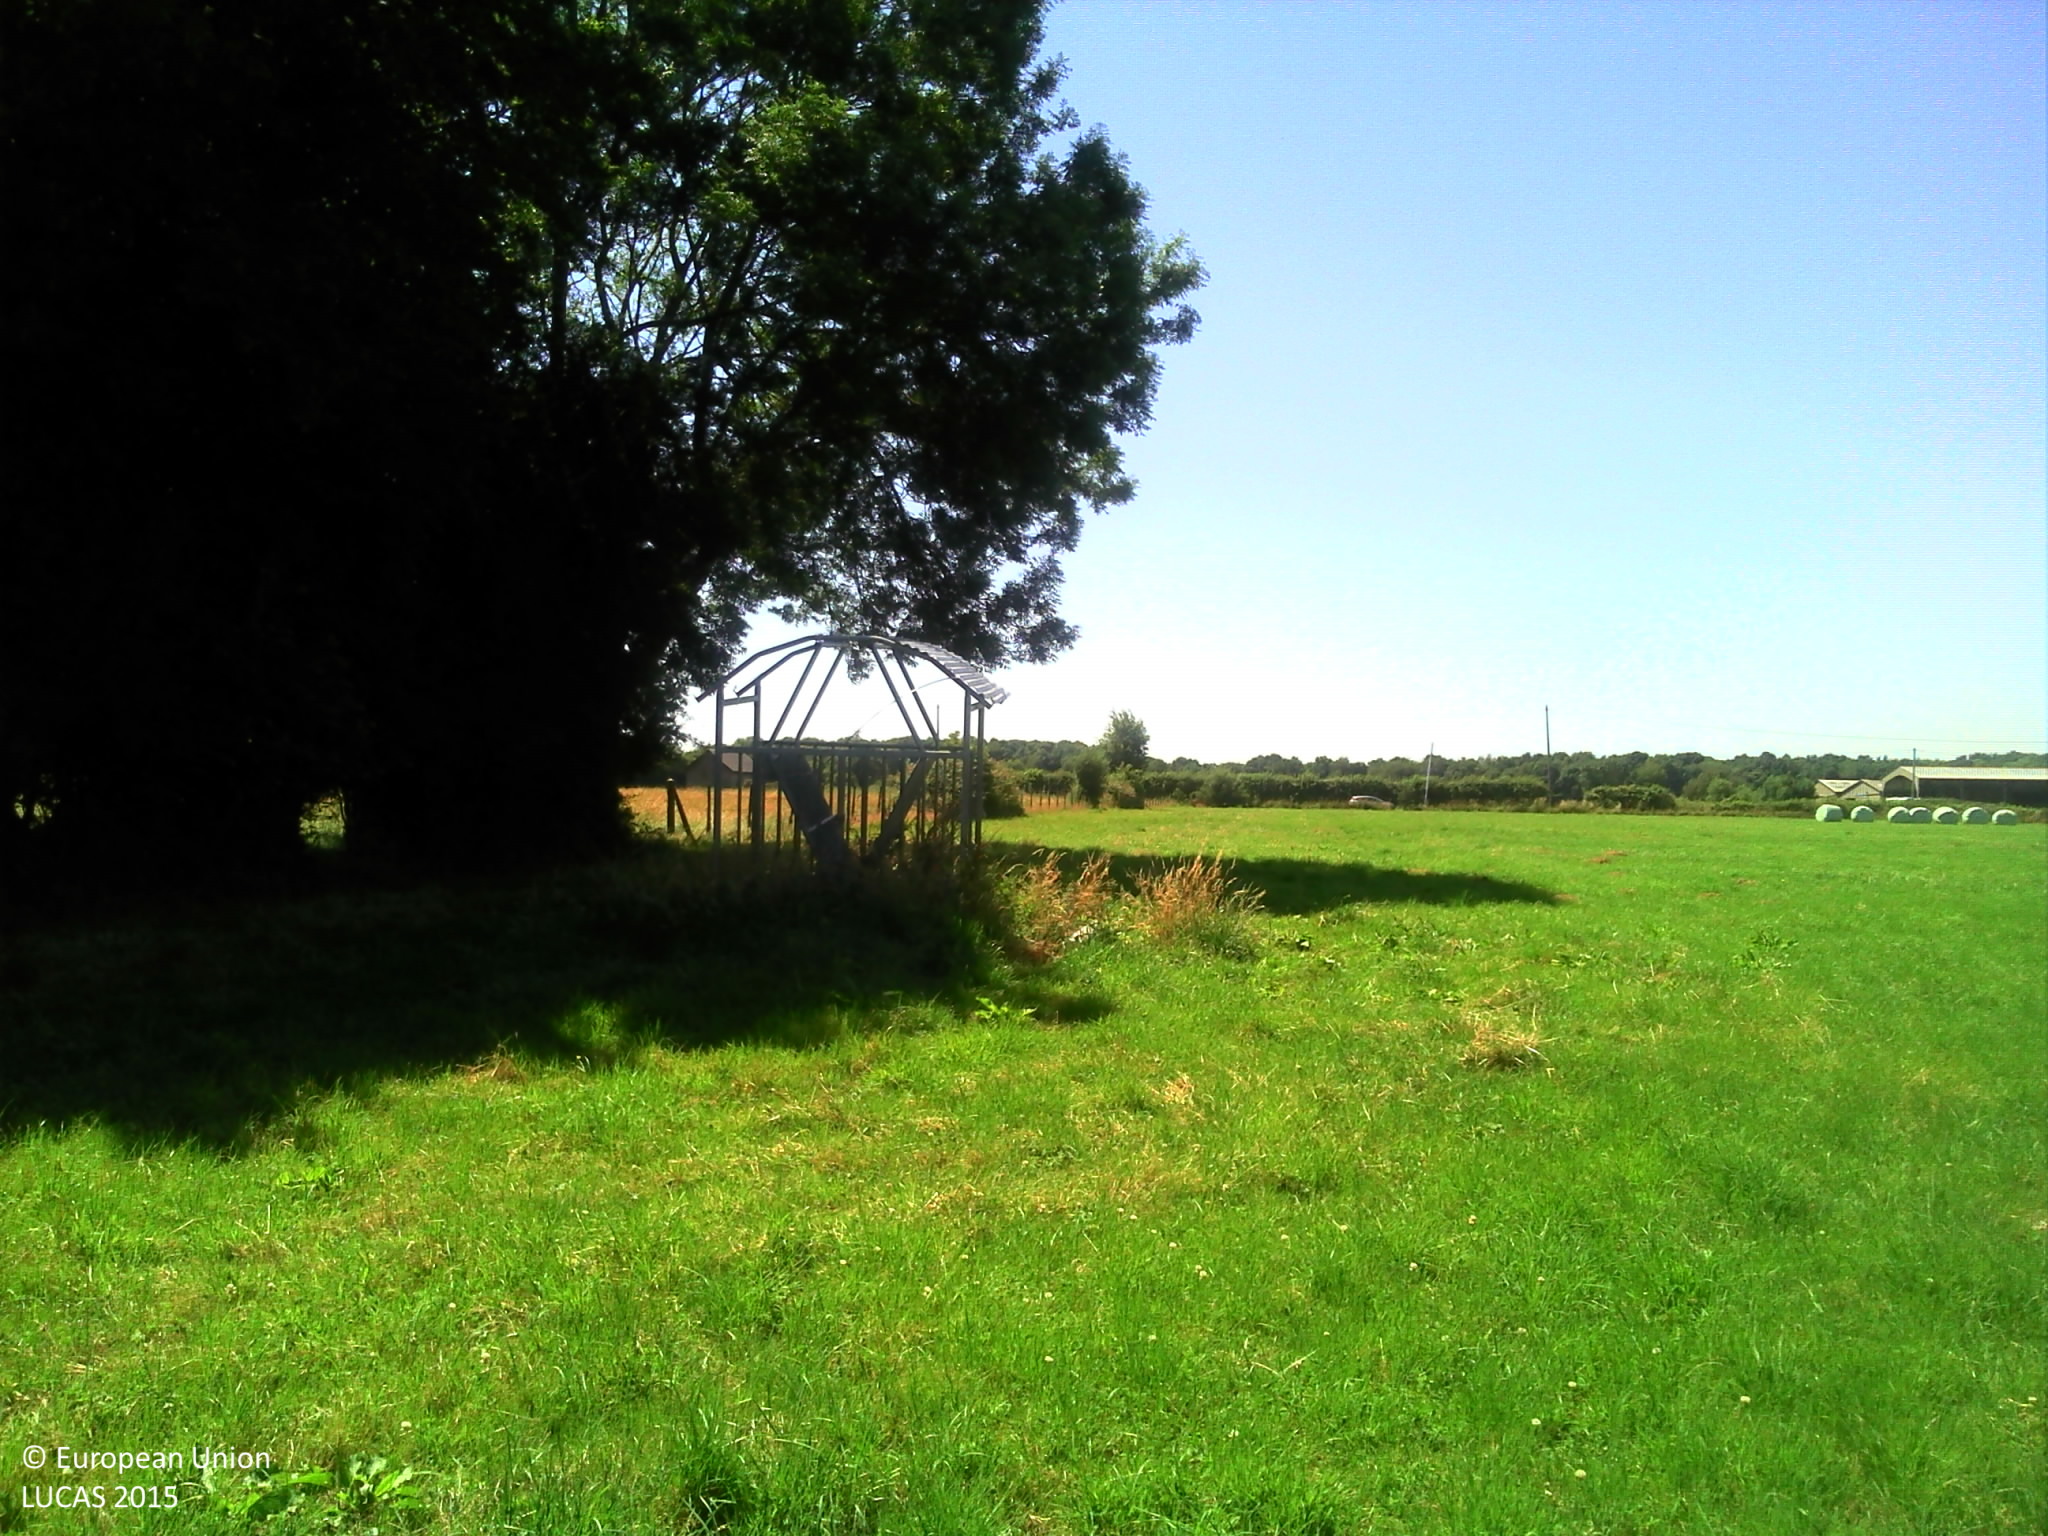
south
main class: Grassland
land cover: Grassland without tree/shrub cover
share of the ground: > 75 %
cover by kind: herbaceous plants 100 %
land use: Agriculture (excluding fallow land and kitchen gardens)
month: July
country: FR
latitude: 49.0521
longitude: 0.3810
